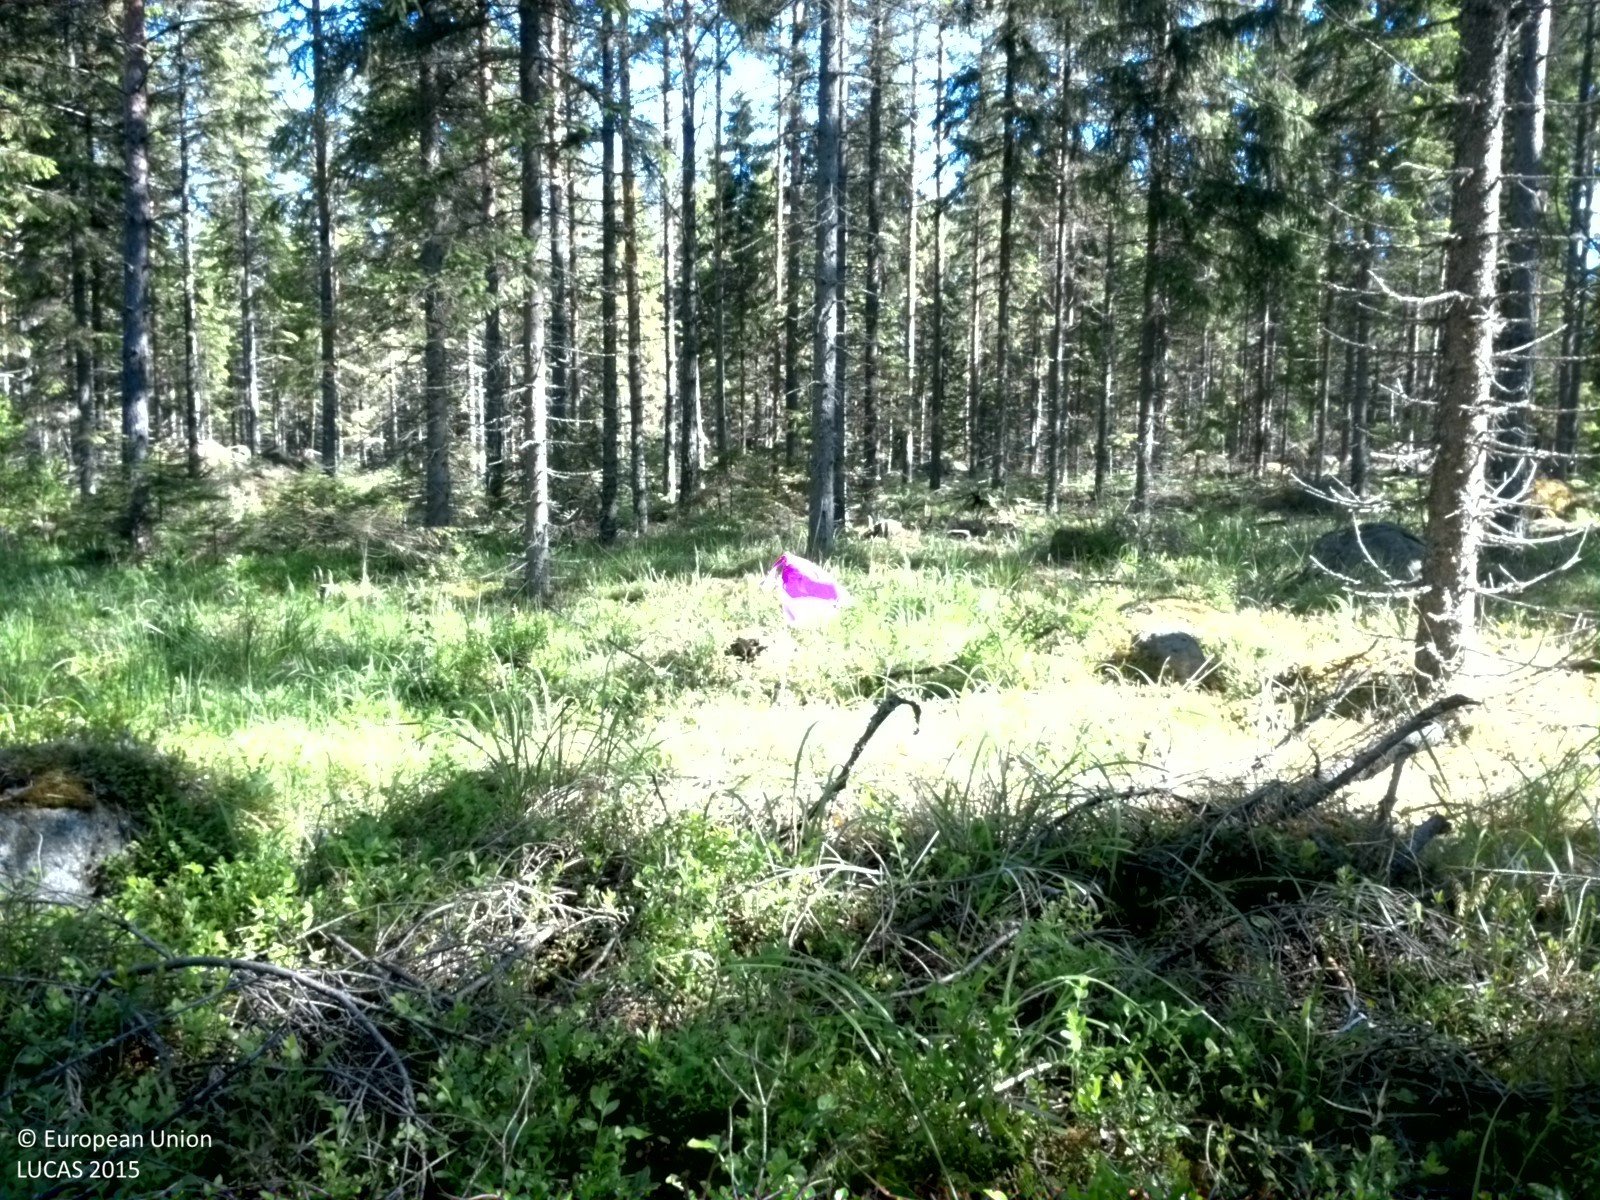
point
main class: Woodland
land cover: Other coniferous woodland
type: boreal forest
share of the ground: 50 - 75 %
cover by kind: coniferous forest trees 60 %, shrubs 15 %, herbaceous plants 10 %, lichens and mosses 10 %, consolidated bare surface 5 %
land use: Forestry
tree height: > 5 m
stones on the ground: 25 - 50 %
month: June
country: SE
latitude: 60.1341
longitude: 17.6806
